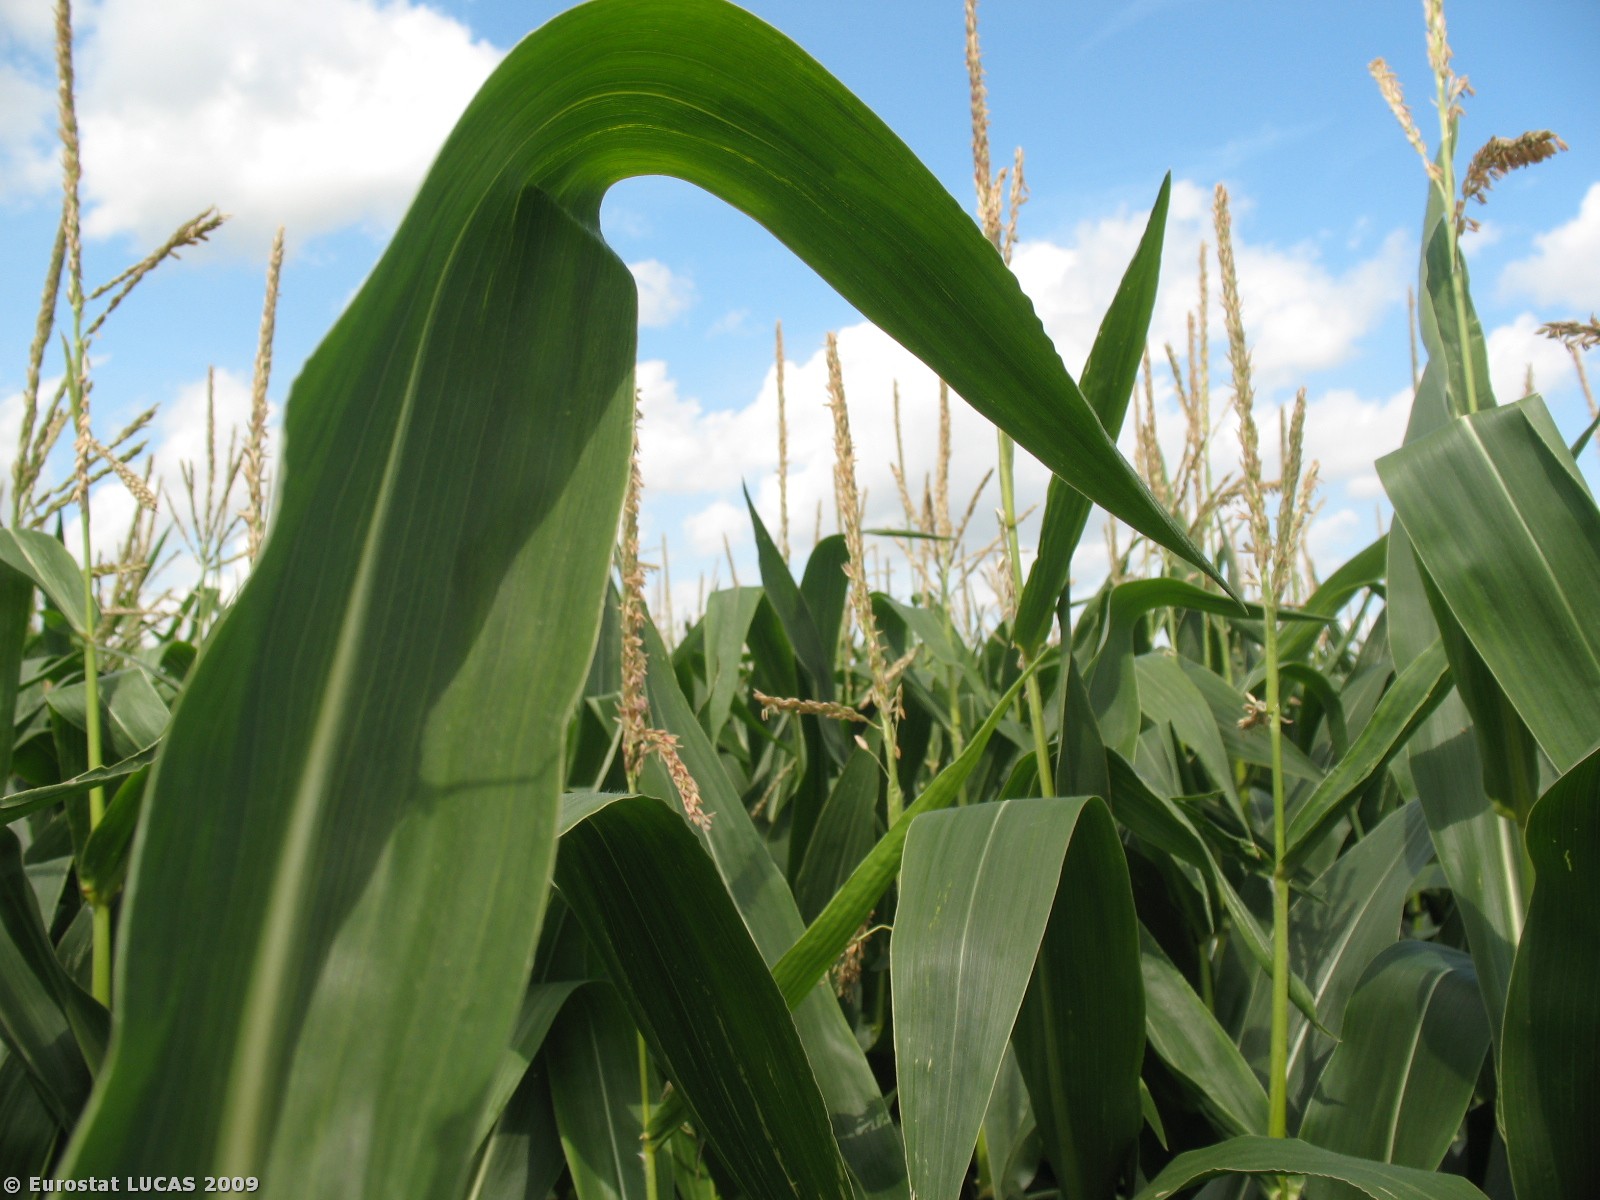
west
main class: Cropland
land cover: Maize
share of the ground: > 75 %
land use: Agriculture (excluding fallow land and kitchen gardens)
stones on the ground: < 10 %
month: July
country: BE
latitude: 50.8592
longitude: 3.7280
